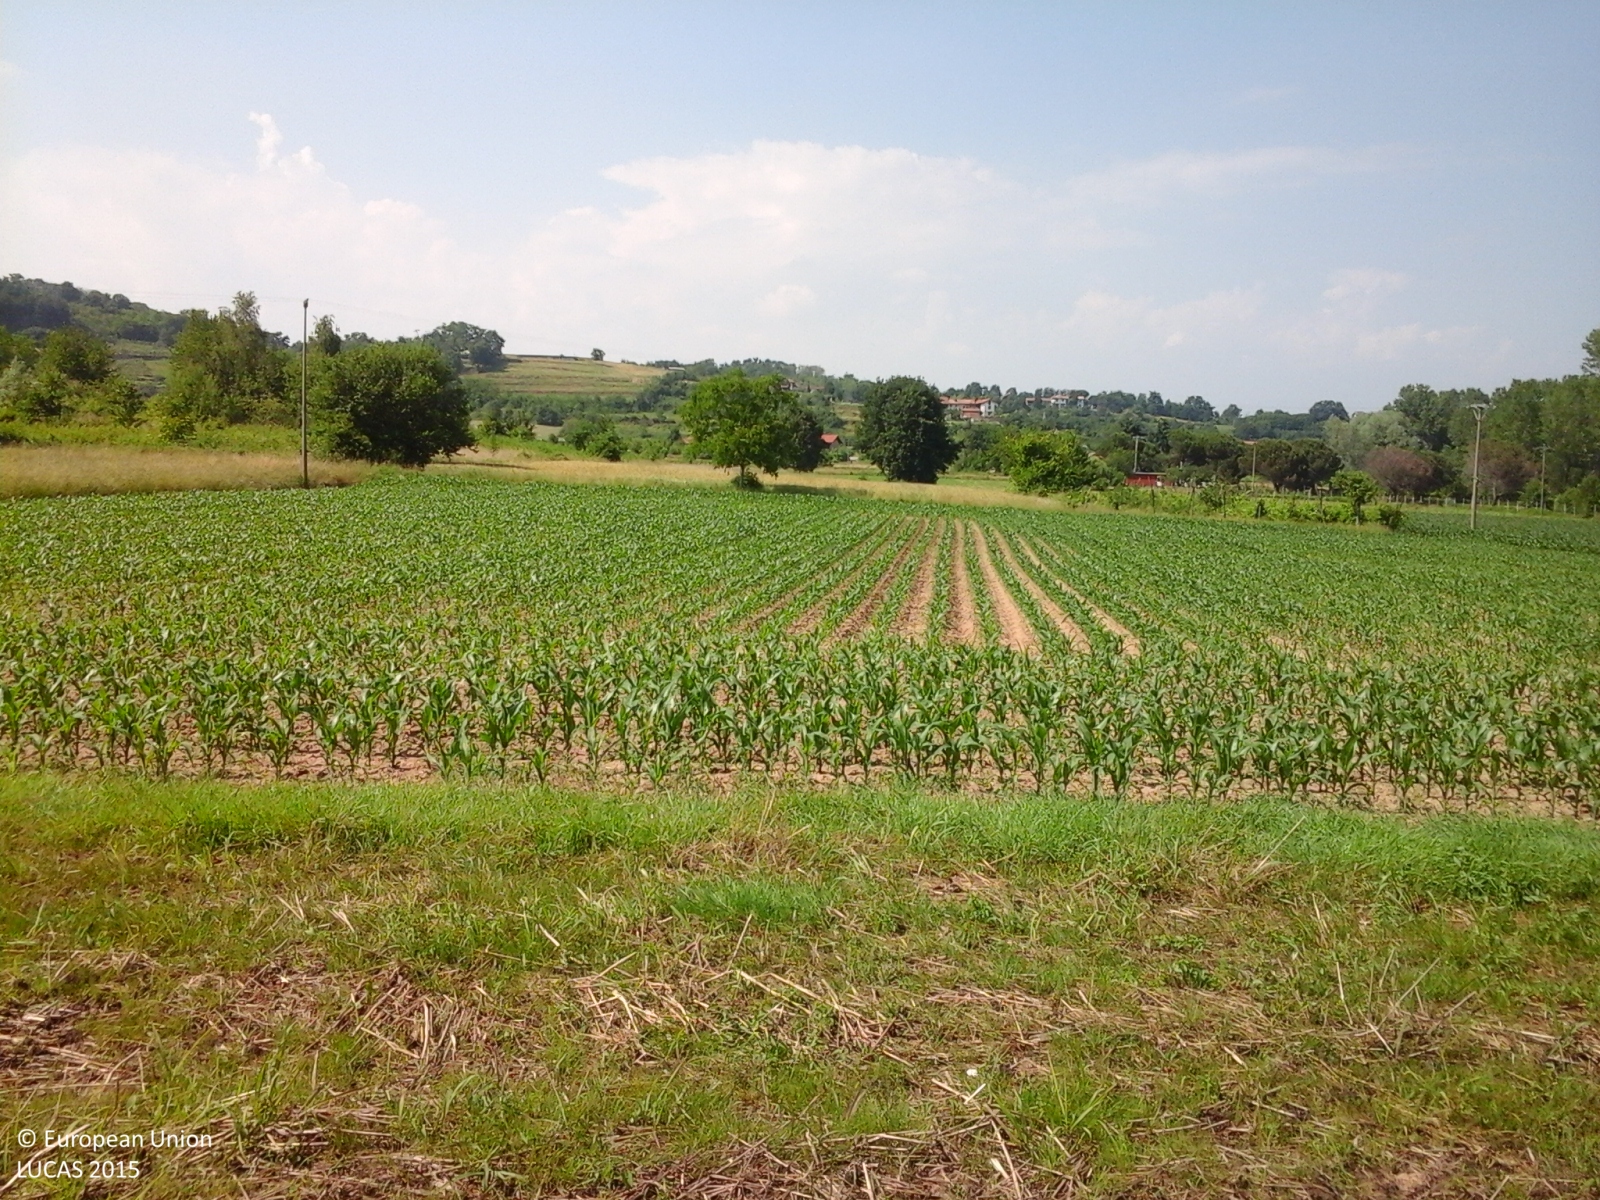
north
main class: Grassland
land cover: Grassland without tree/shrub cover
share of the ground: > 75 %
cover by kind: herbaceous plants 100 %
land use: Agriculture (excluding fallow land and kitchen gardens)
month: June
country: IT
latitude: 45.4332
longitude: 8.0985
